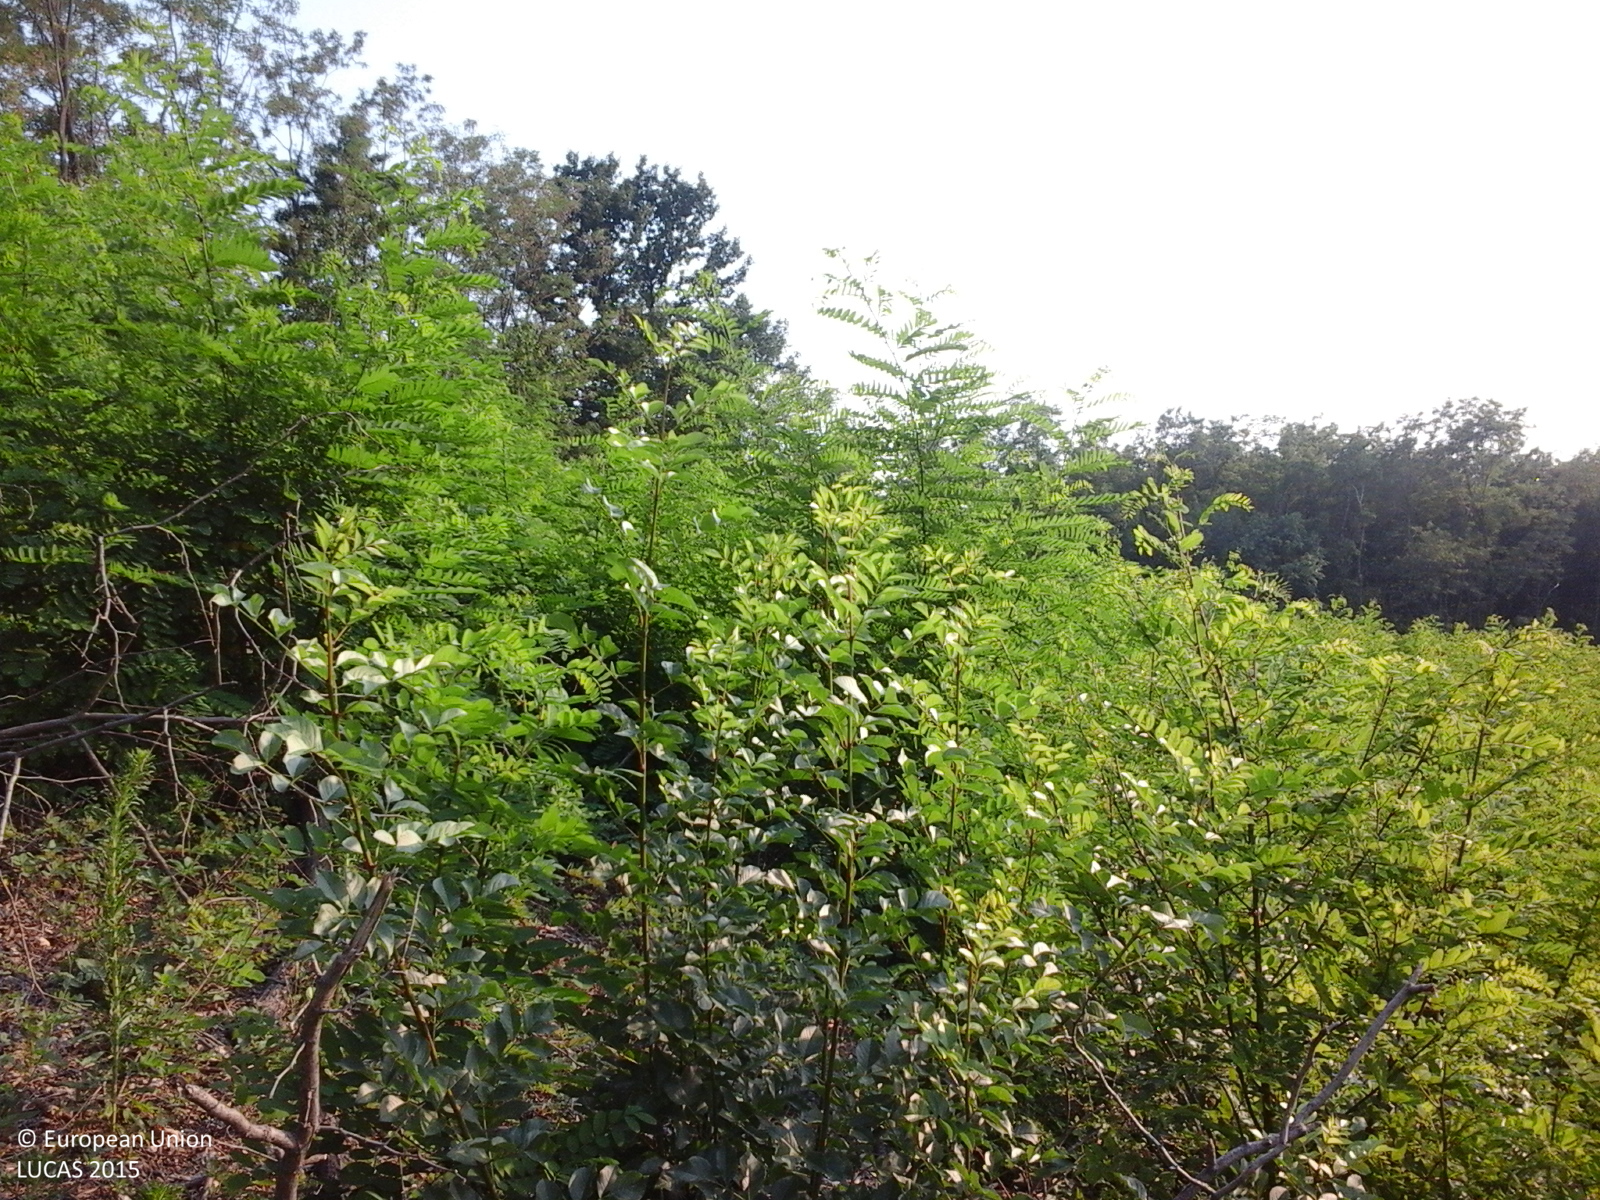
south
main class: Shrubland
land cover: Shrubland with sparse tree cover
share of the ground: > 75 %
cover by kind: shrubs 95 %, broadleaved forest trees 5 %
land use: Forestry
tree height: < 5 m
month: July
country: RO
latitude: 44.8644
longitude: 24.4893
